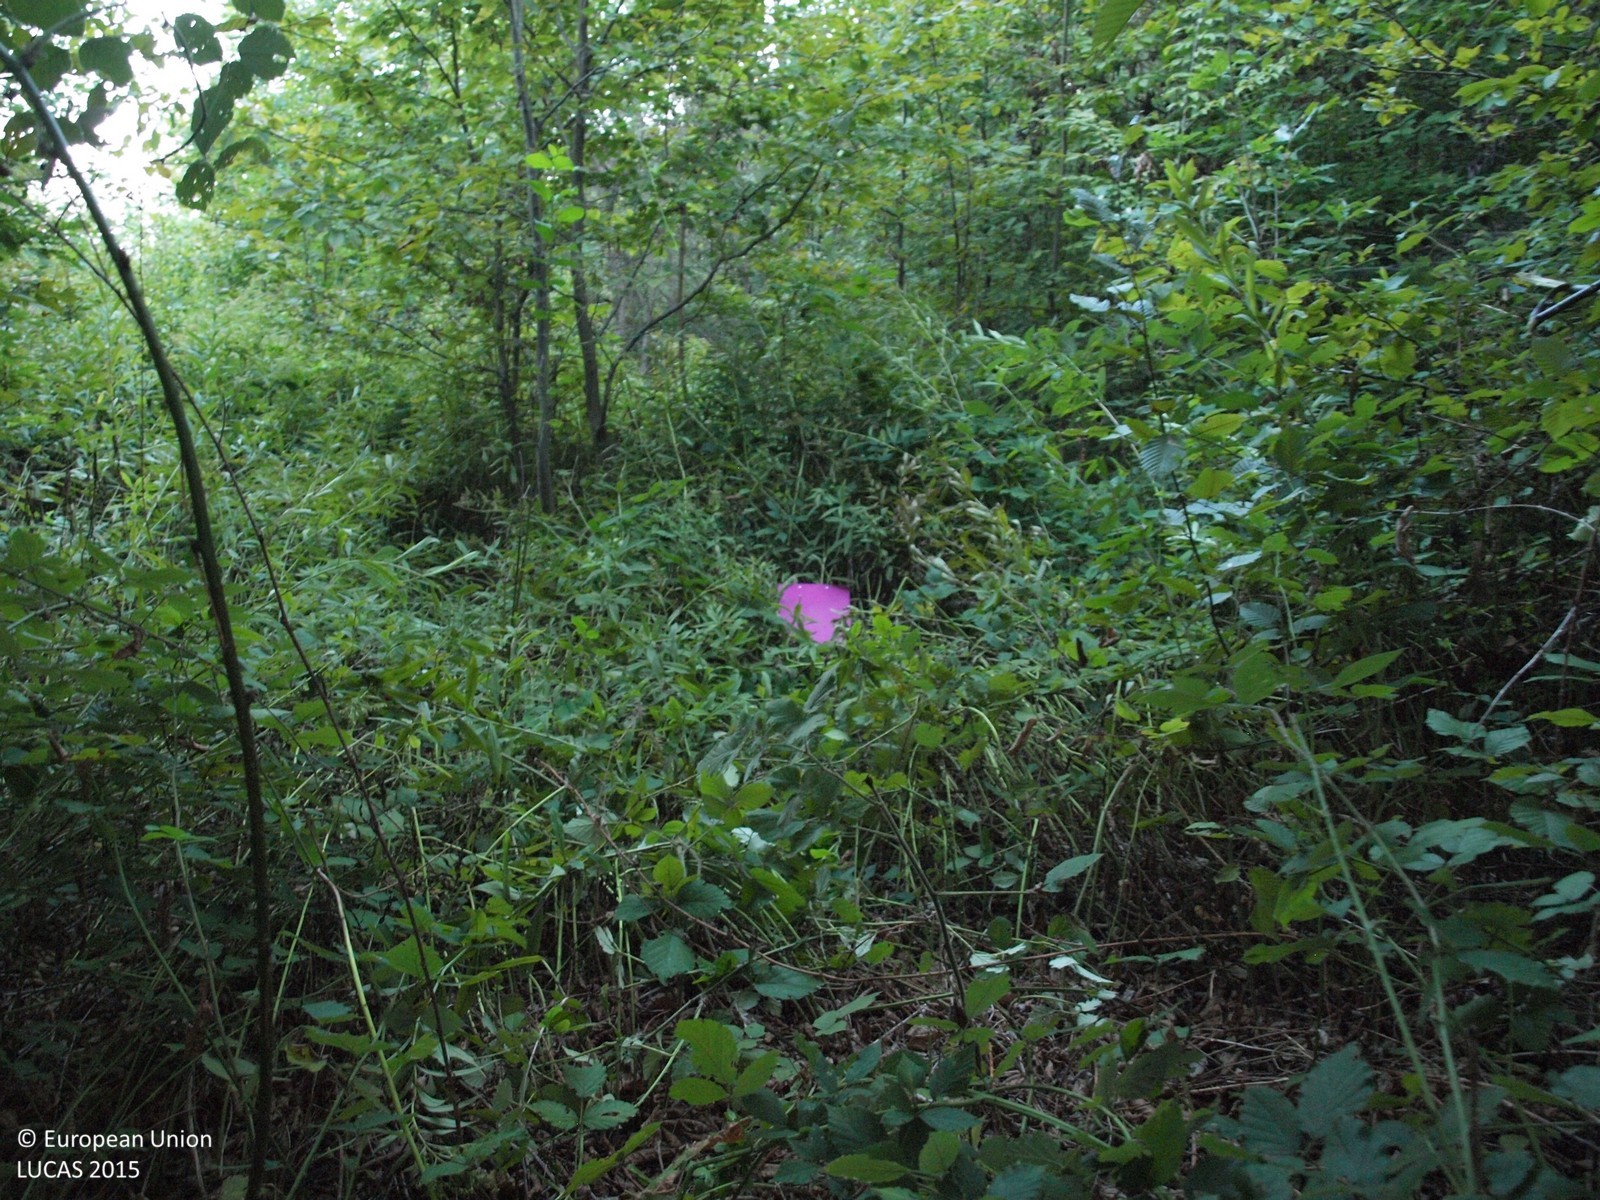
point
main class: Woodland
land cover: Broadleaved woodland
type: mesophytic deciduous forest
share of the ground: > 75 %
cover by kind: broadleaved forest trees 100 %
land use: Forestry
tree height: > 5 m
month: September
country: HR
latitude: 45.5653
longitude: 16.0576
